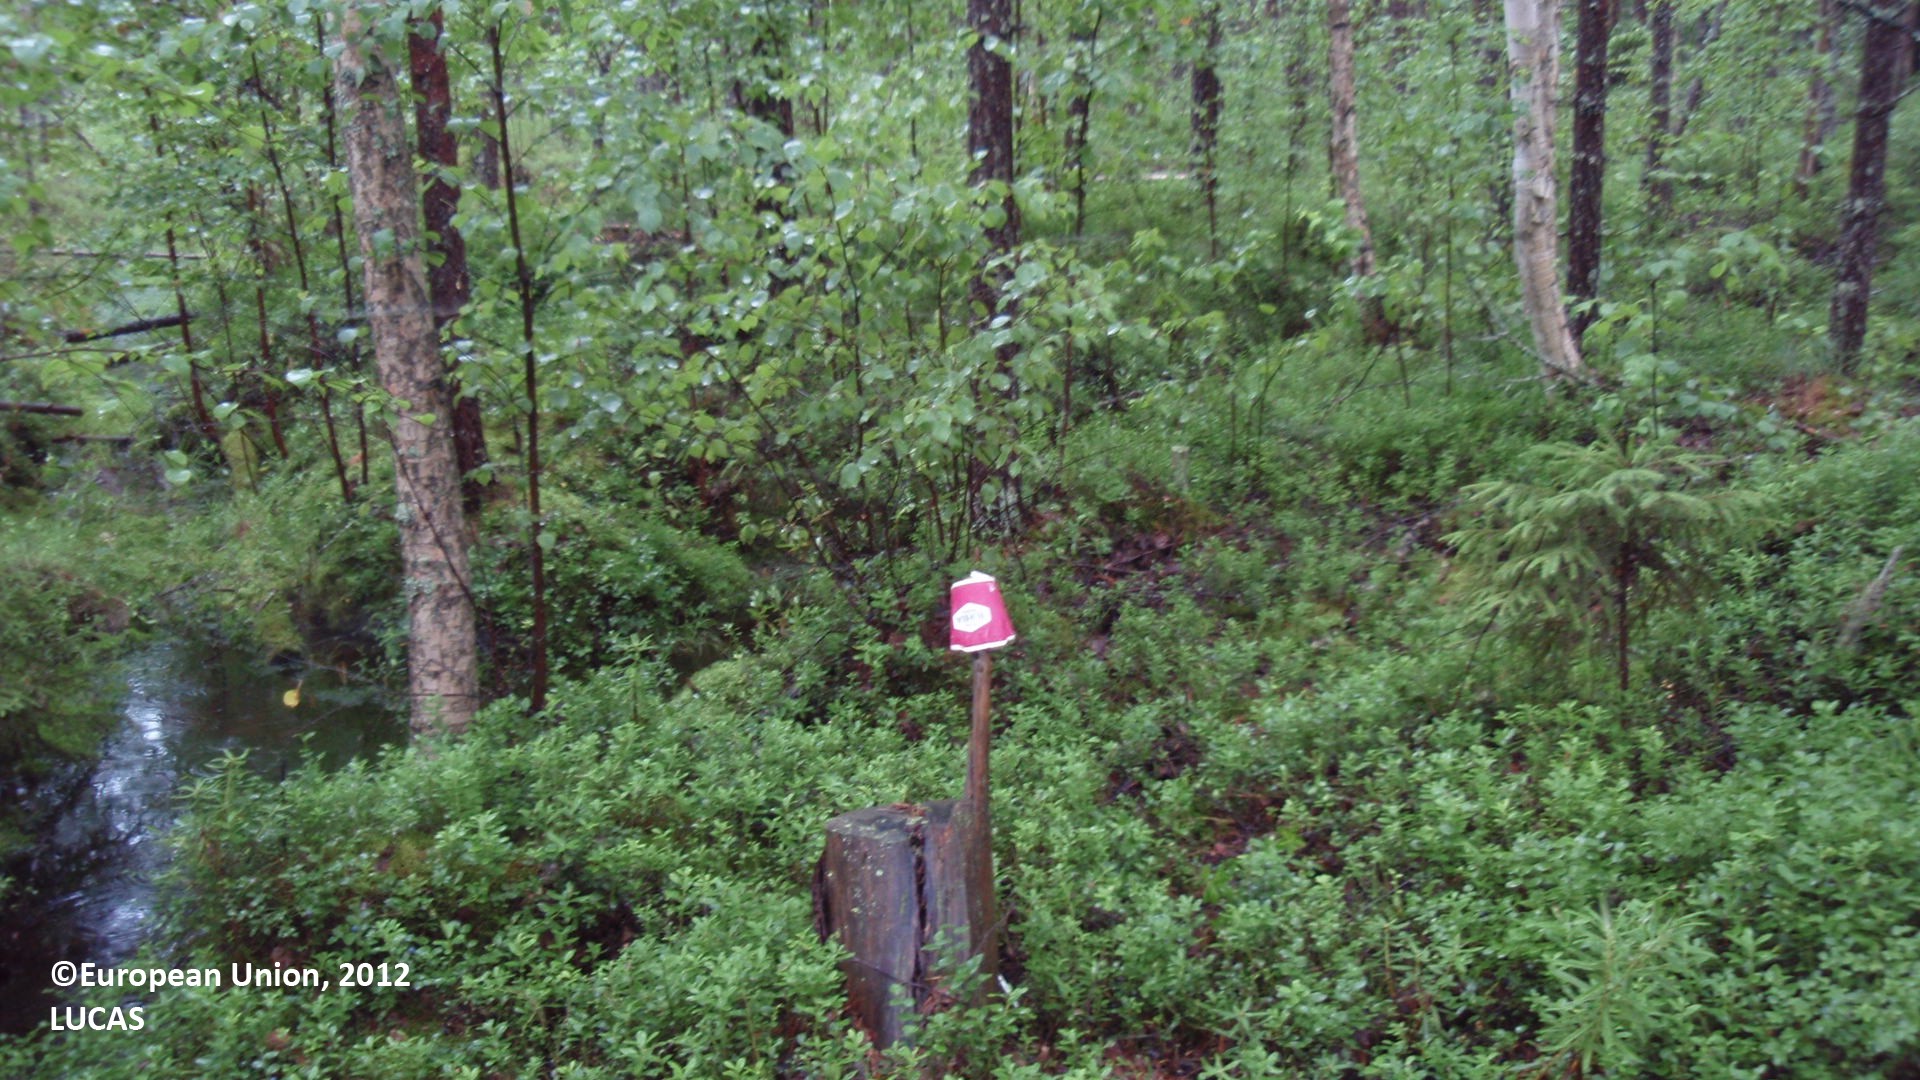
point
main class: Woodland
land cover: Pine dominated mixed woodland
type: boreal forest
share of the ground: > 75 %
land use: Forestry
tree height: > 5 m
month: July
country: FI
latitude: 61.4286
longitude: 27.0138
